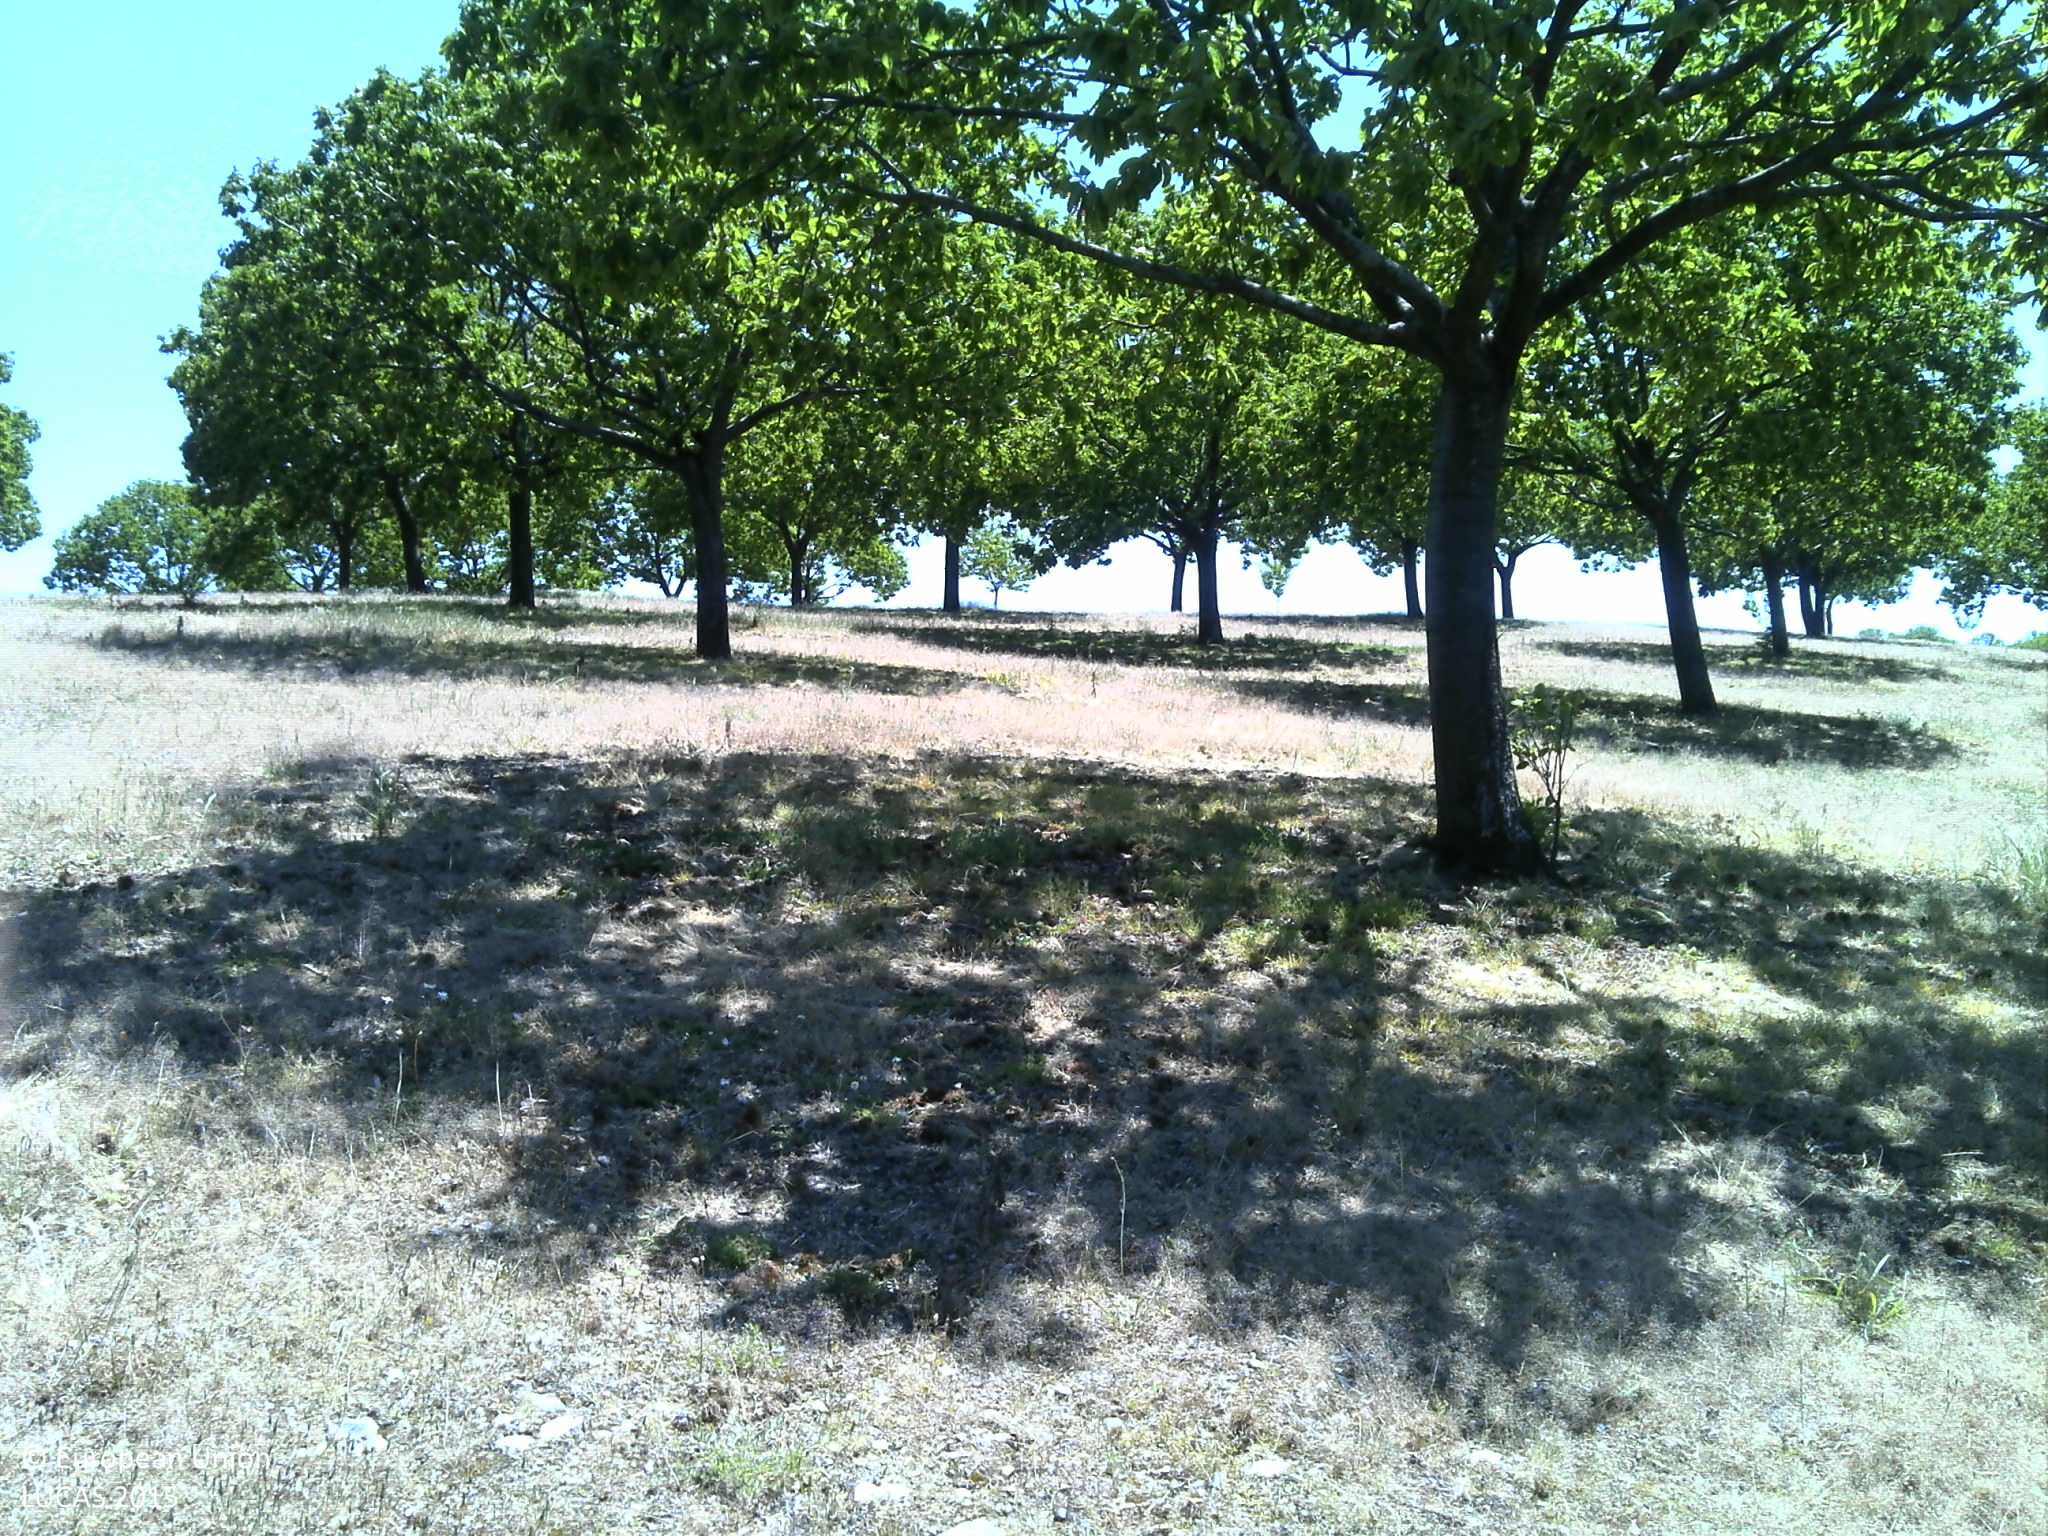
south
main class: Cropland
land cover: Nuts trees
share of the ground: 25 - 50 %
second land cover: Spontaneously vegetated surfaces
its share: 10 - 25 %
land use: Agriculture (excluding fallow land and kitchen gardens)
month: May
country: PT
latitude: 41.5627
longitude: -7.4787
